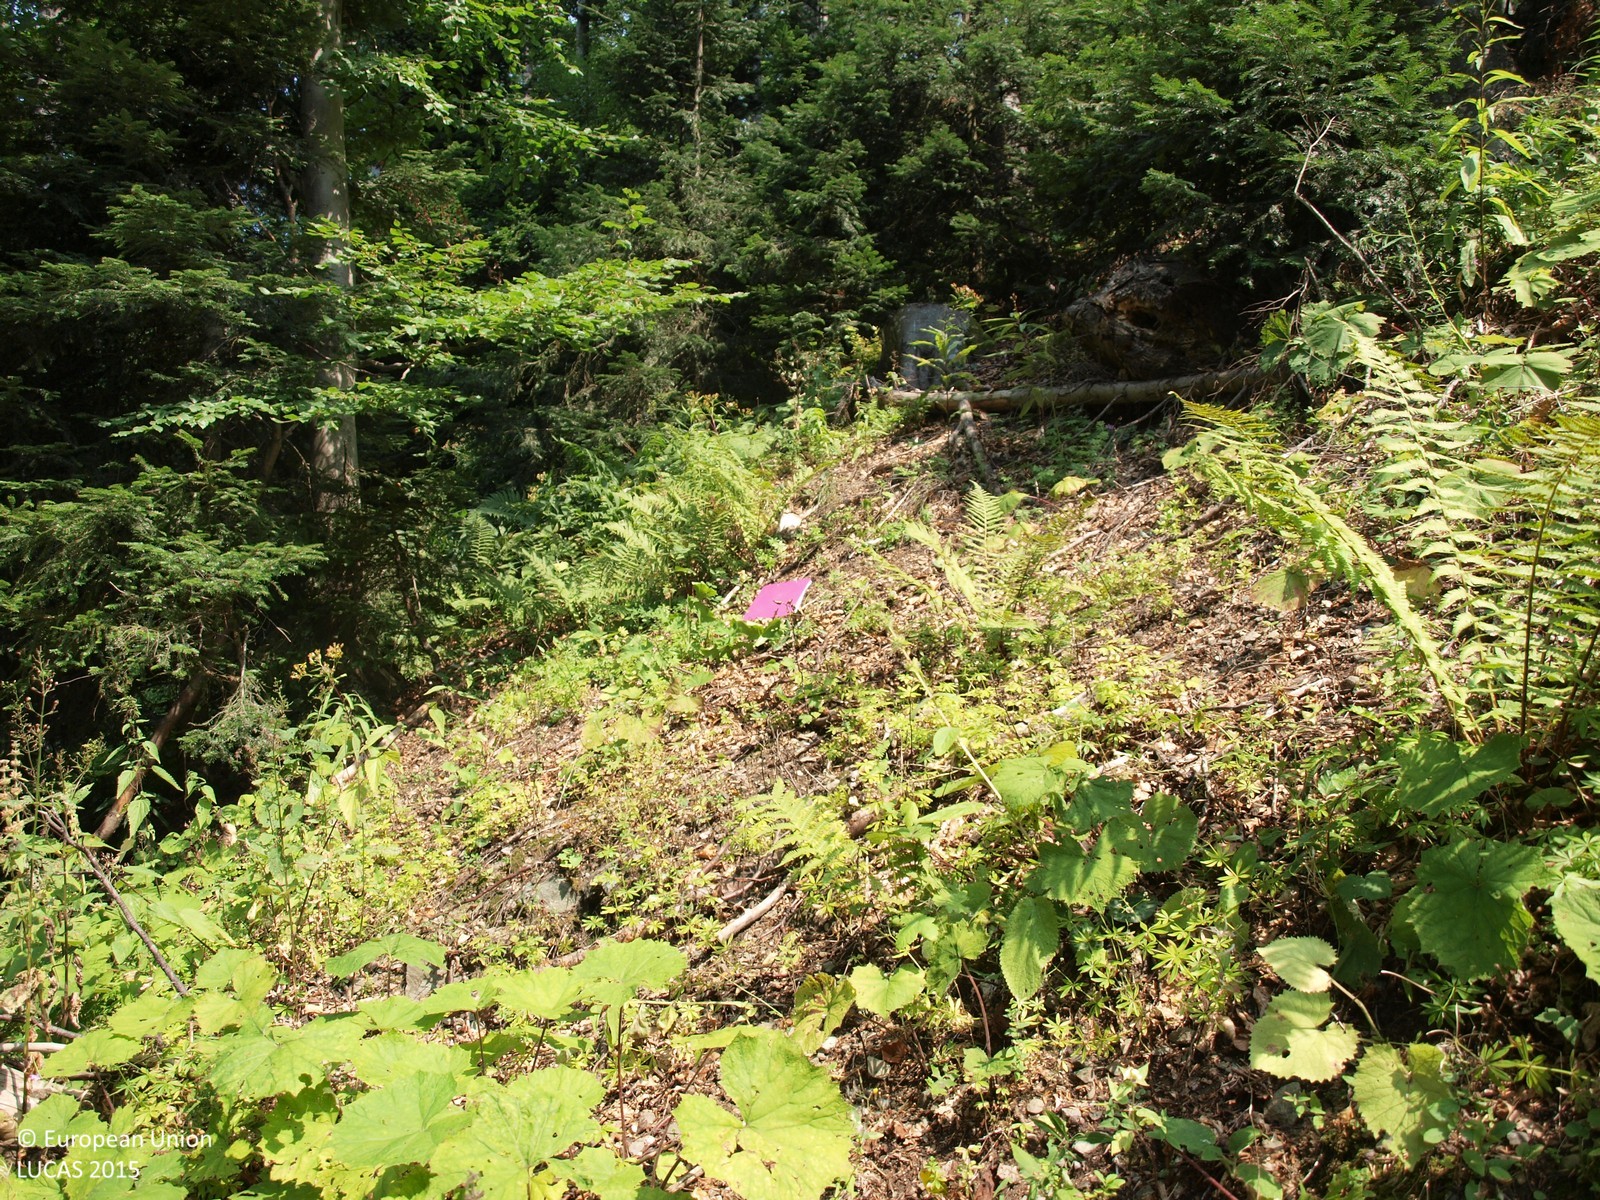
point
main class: Woodland
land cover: Broadleaved woodland
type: beech forest
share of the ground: > 75 %
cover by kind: broadleaved forest trees 65 %, coniferous forest trees 15 %, shrubs 10 %, herbaceous plants 10 %
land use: Forestry
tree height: > 5 m
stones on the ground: < 10 %
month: August
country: HR
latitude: 45.8972
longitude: 15.9397
